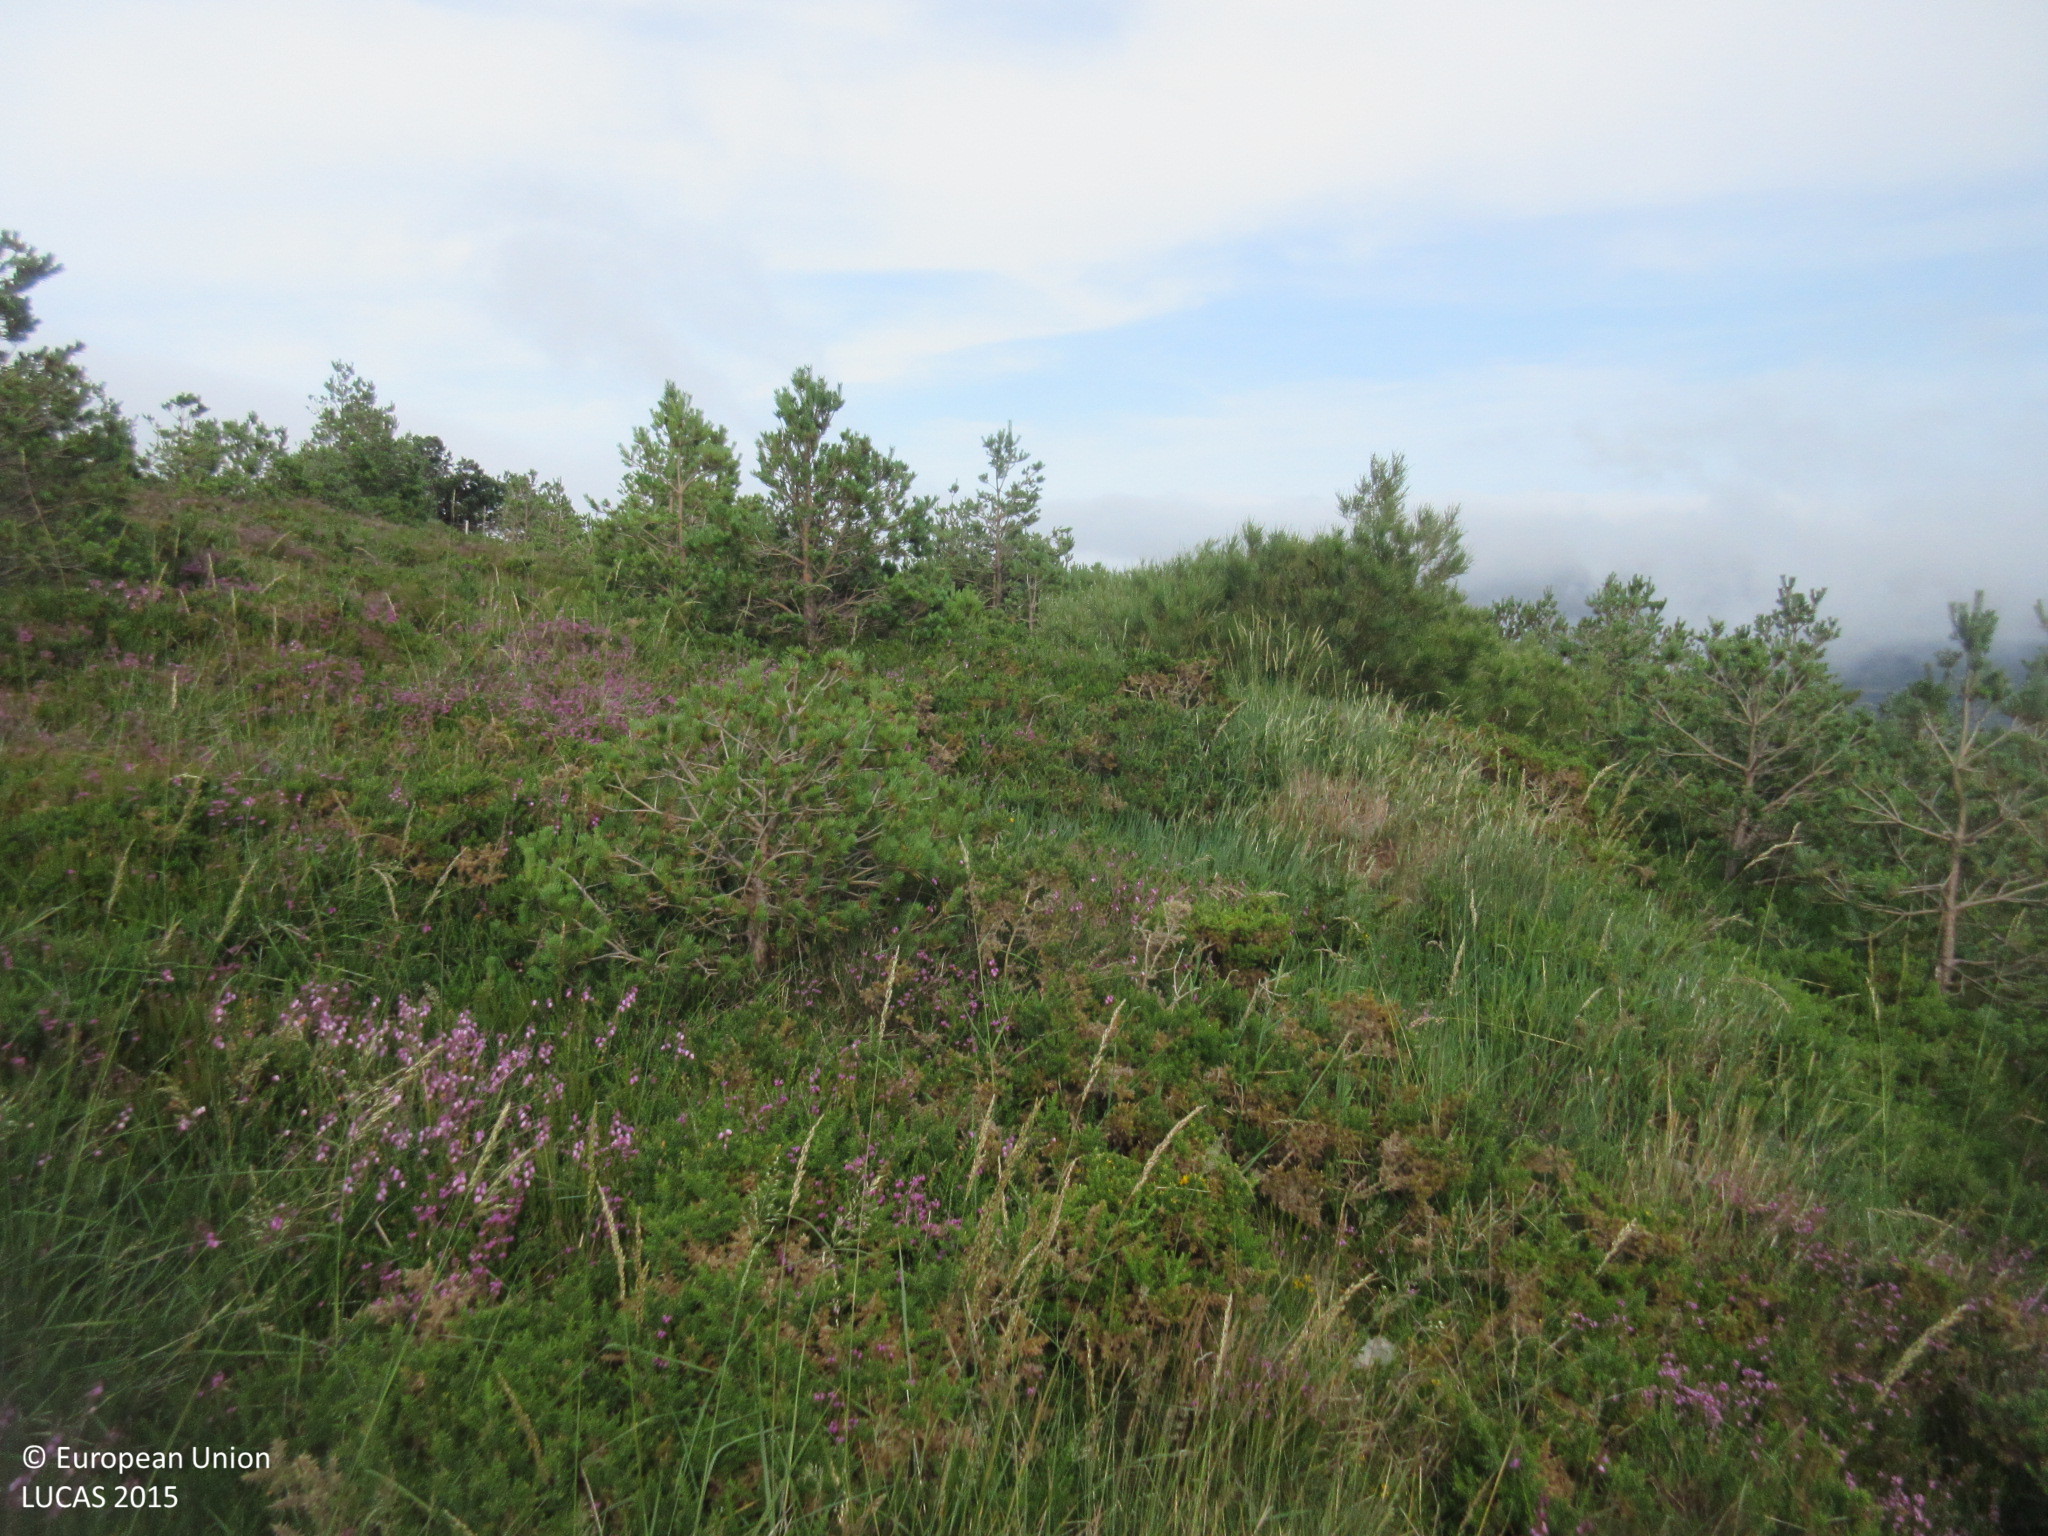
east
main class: Woodland
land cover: Pine dominated coniferous woodland
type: hemiboreal forest and nemoral coniferous forest and mixed broadleaved-coniferous forest
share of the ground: 25 - 50 %
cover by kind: shrubs 55 %, coniferous forest trees 45 %
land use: Forestry
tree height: < 5 m
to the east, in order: Pine dominated coniferous woodland; Fences; Shrubland without tree cover; Tracks; Shrubland without tree cover; Broadleaved woodland
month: July
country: ES
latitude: 43.1135
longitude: -3.5228
